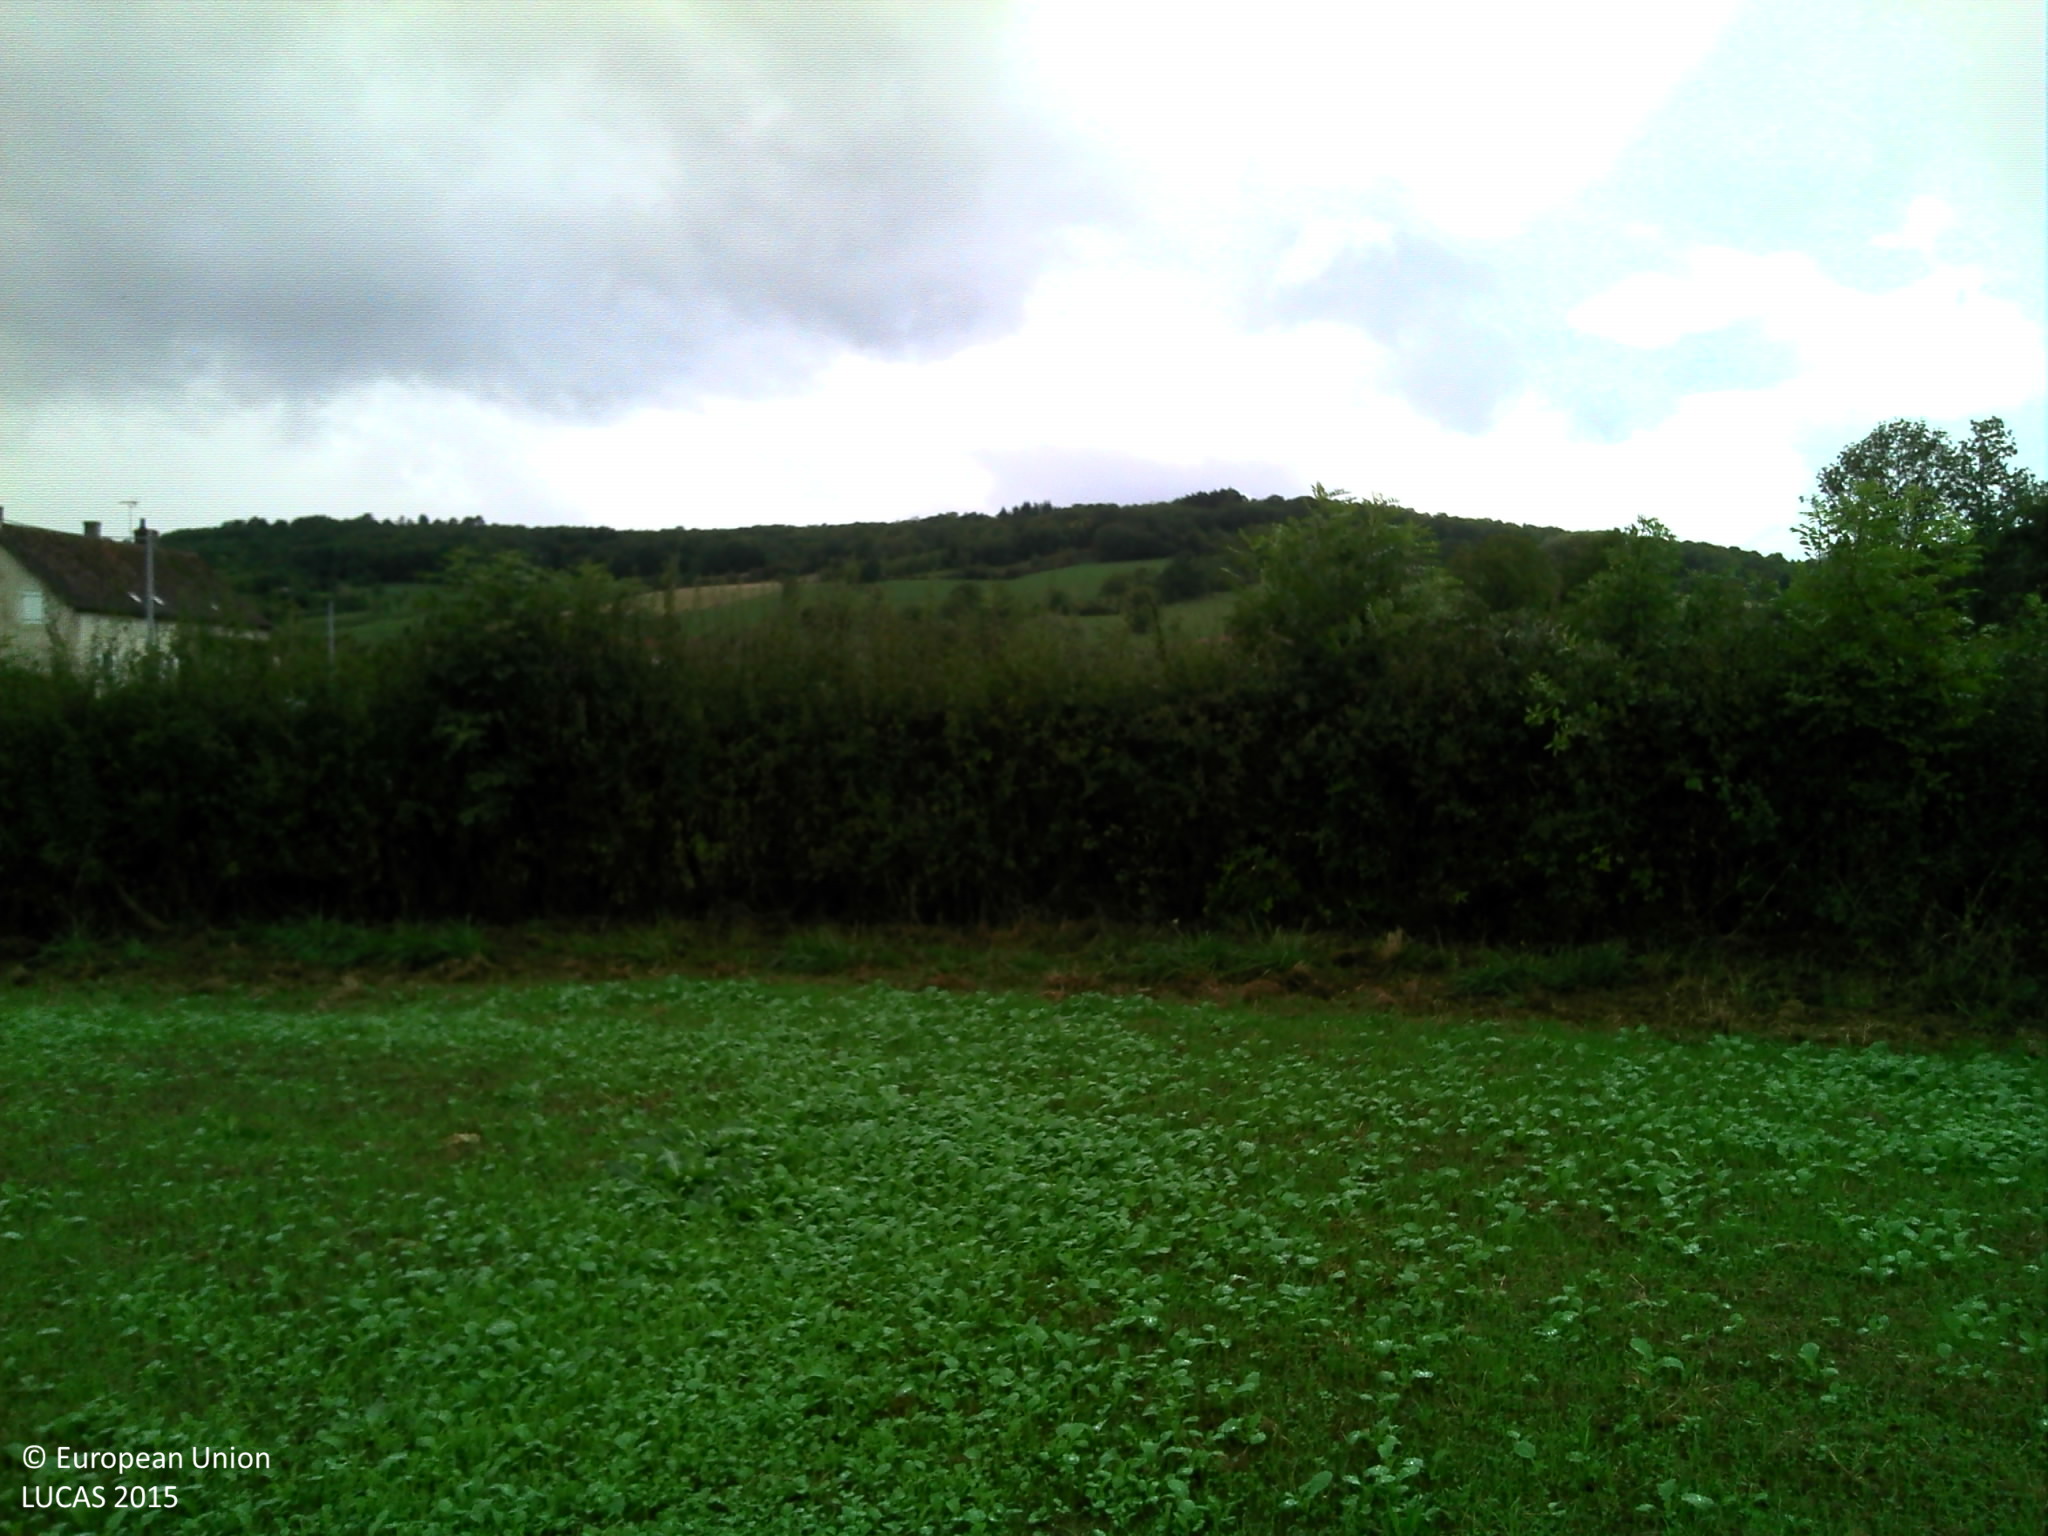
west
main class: Cropland
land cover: Rape and turnip rape
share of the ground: 25 - 50 %
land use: Agriculture (excluding fallow land and kitchen gardens)
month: September
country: FR
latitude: 47.3264
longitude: 4.4552
